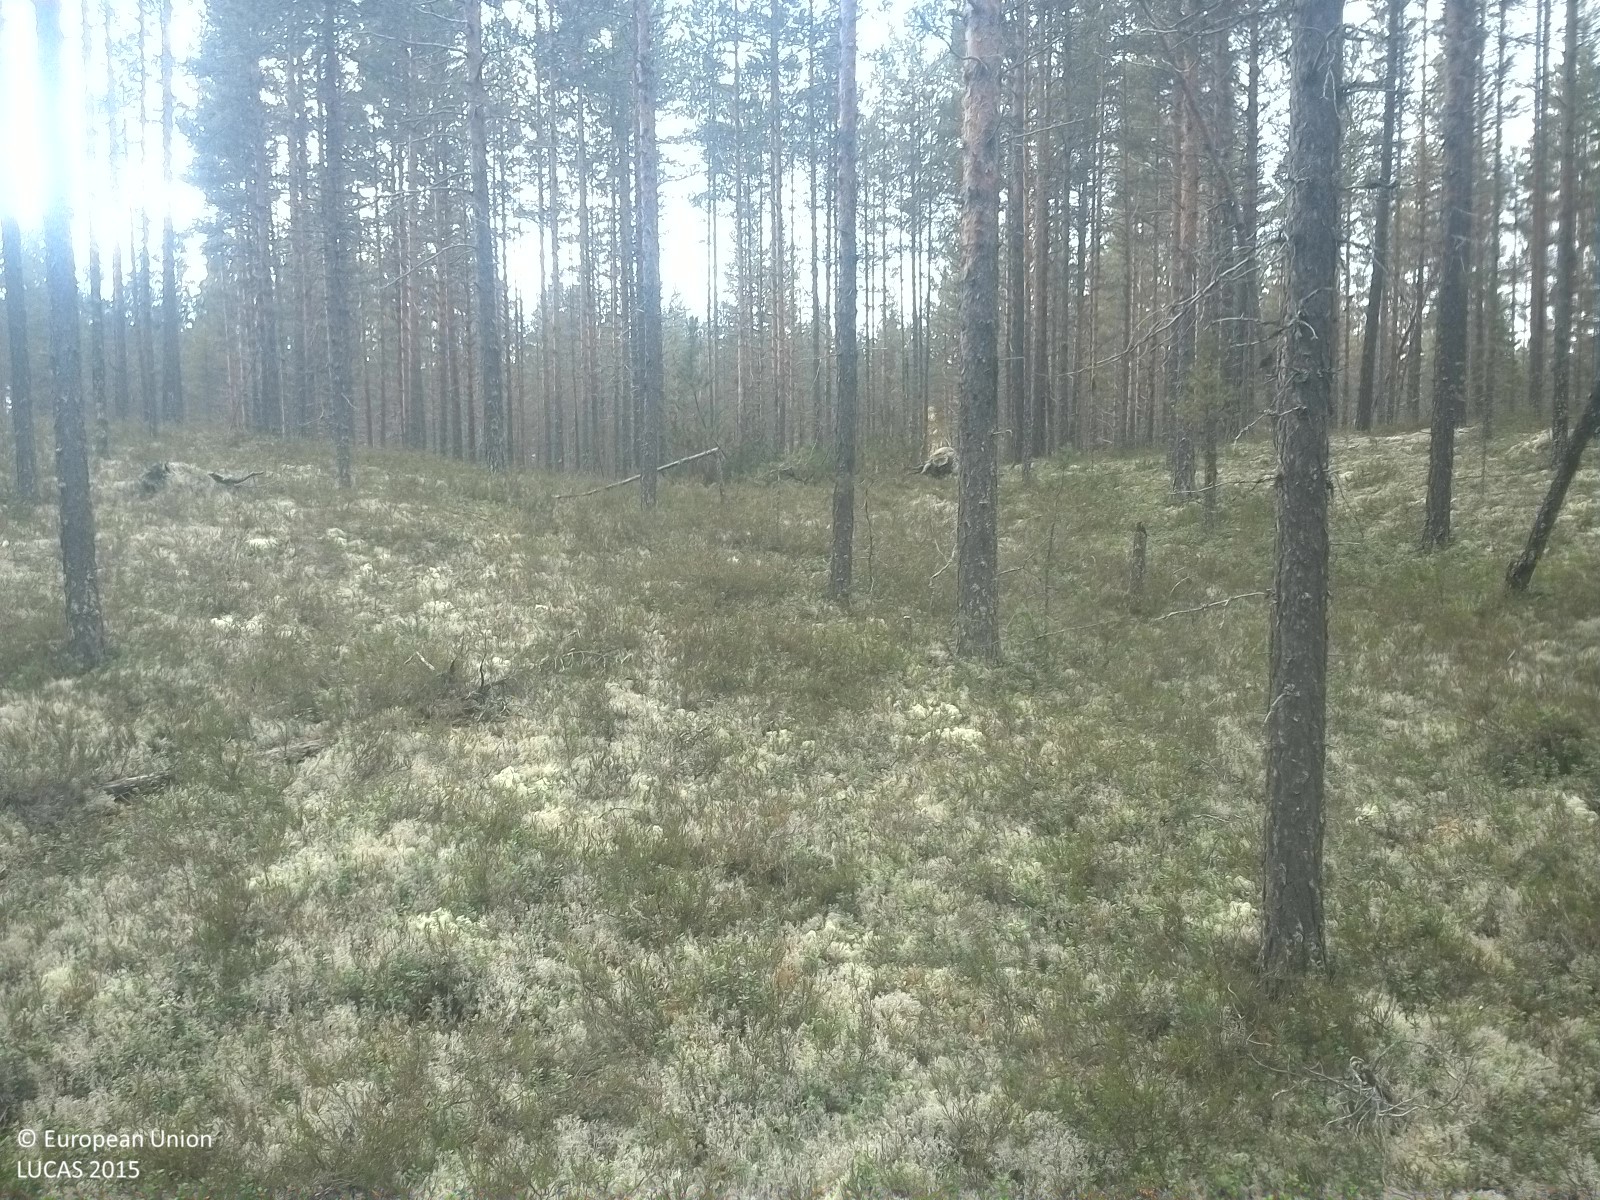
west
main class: Woodland
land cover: Pine dominated coniferous woodland
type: boreal forest
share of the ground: 50 - 75 %
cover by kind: coniferous forest trees 50 %, lichens and mosses 40 %, shrubs 10 %
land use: Forestry
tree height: > 5 m
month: September
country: SE
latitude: 62.2033
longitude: 15.5361
